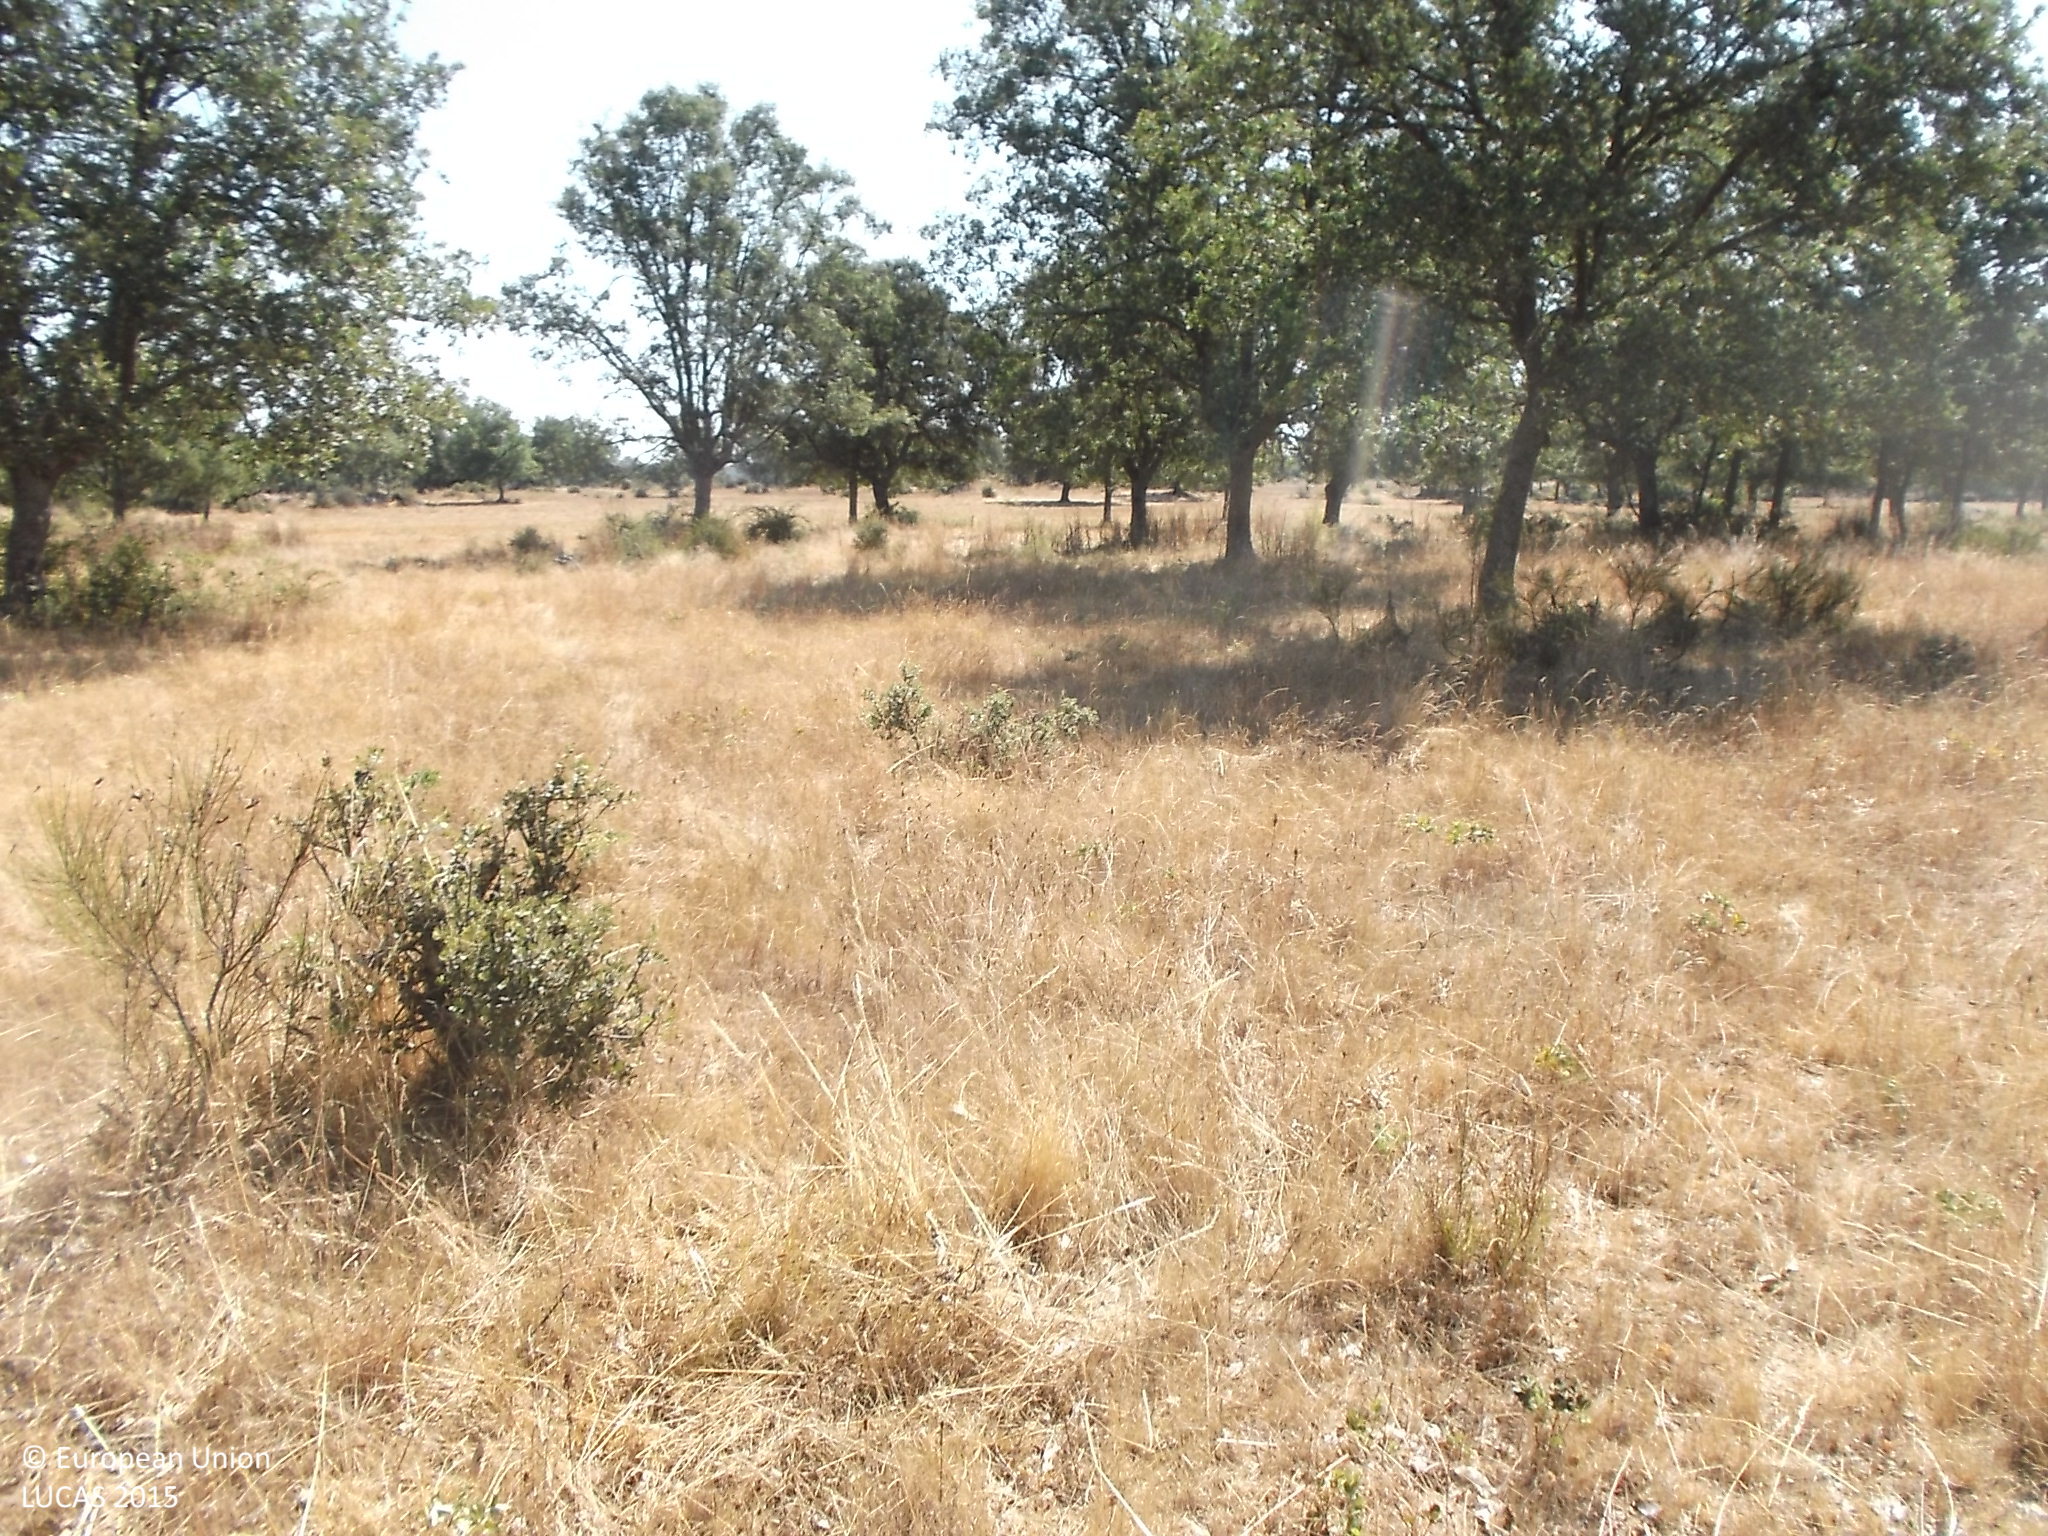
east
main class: Woodland
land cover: Broadleaved woodland
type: broadleaved evergreen forest
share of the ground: 10 - 25 %
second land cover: Shrubland without tree cover
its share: 25 - 50 %
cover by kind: shrubs 40 %, herbaceous plants 35 %, broadleaved forest trees 25 %
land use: Forestry
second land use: Agriculture (excluding fallow land and kitchen gardens)
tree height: < 5 m
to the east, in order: Broadleaved woodland; Shrubland without tree cover; Grassland without tree/shrub cover; Broadleaved woodland; Grassland without tree/shrub cover
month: July
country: ES
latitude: 41.3543
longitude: -5.9987
